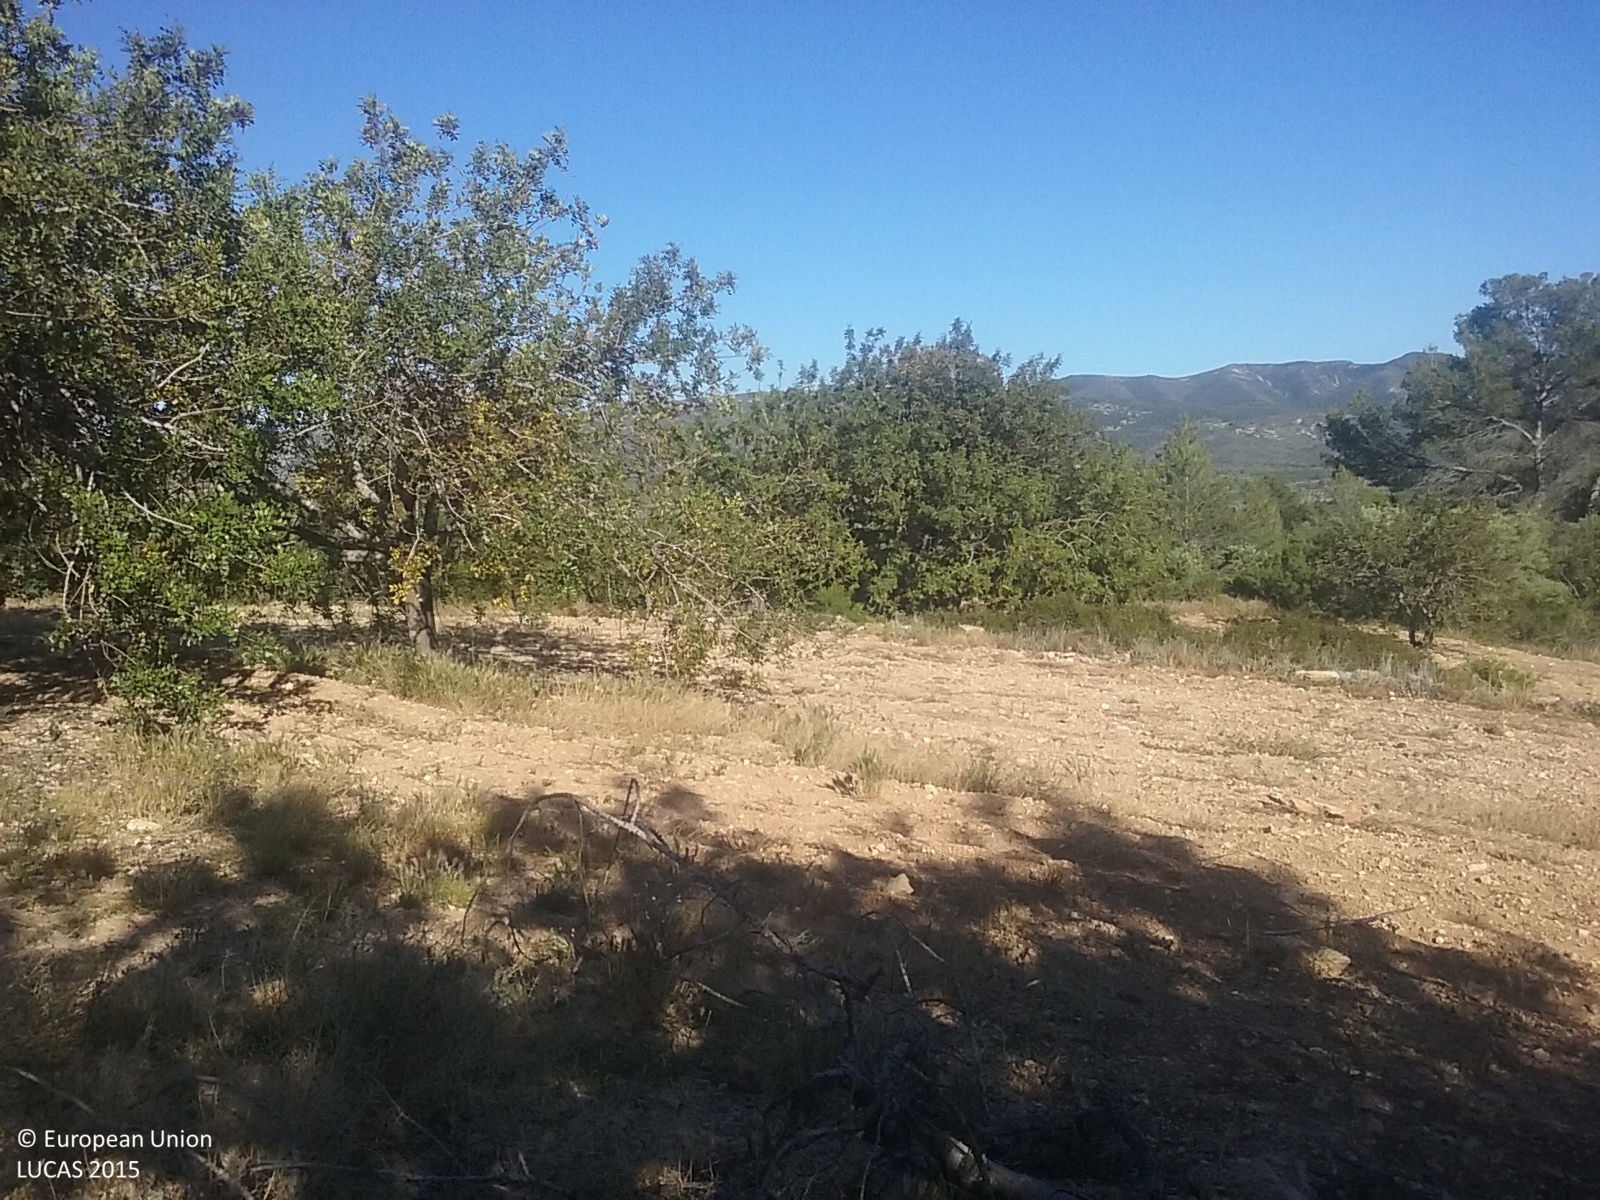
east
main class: Cropland
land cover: Permanent industrial crops
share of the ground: 10 - 25 %
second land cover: Other bare soil
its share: > 75 %
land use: Agriculture (excluding fallow land and kitchen gardens)
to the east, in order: Permanent industrial crops; Other bare soil; Shrubland with sparse tree cover; Dry stone walls; Shrubland with sparse tree cover; Dry stone walls; Shrubland with sparse tree cover; Dry stone walls; Shrubland with sparse tree cover; Dry stone walls; Abandoned hedges; Permanent industrial crops; Dry stone walls; Permanent industrial crops; Shrubland with sparse tree cover; Nuts trees; Dry stone walls; Shrubland with sparse tree cover; Nuts trees; Dry stone walls; Olive groves; Dry stone walls; Shrubland with sparse tree cover; Dry stone walls; Shrubland with sparse tree cover
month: May
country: ES
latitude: 40.3439
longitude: 0.2374
